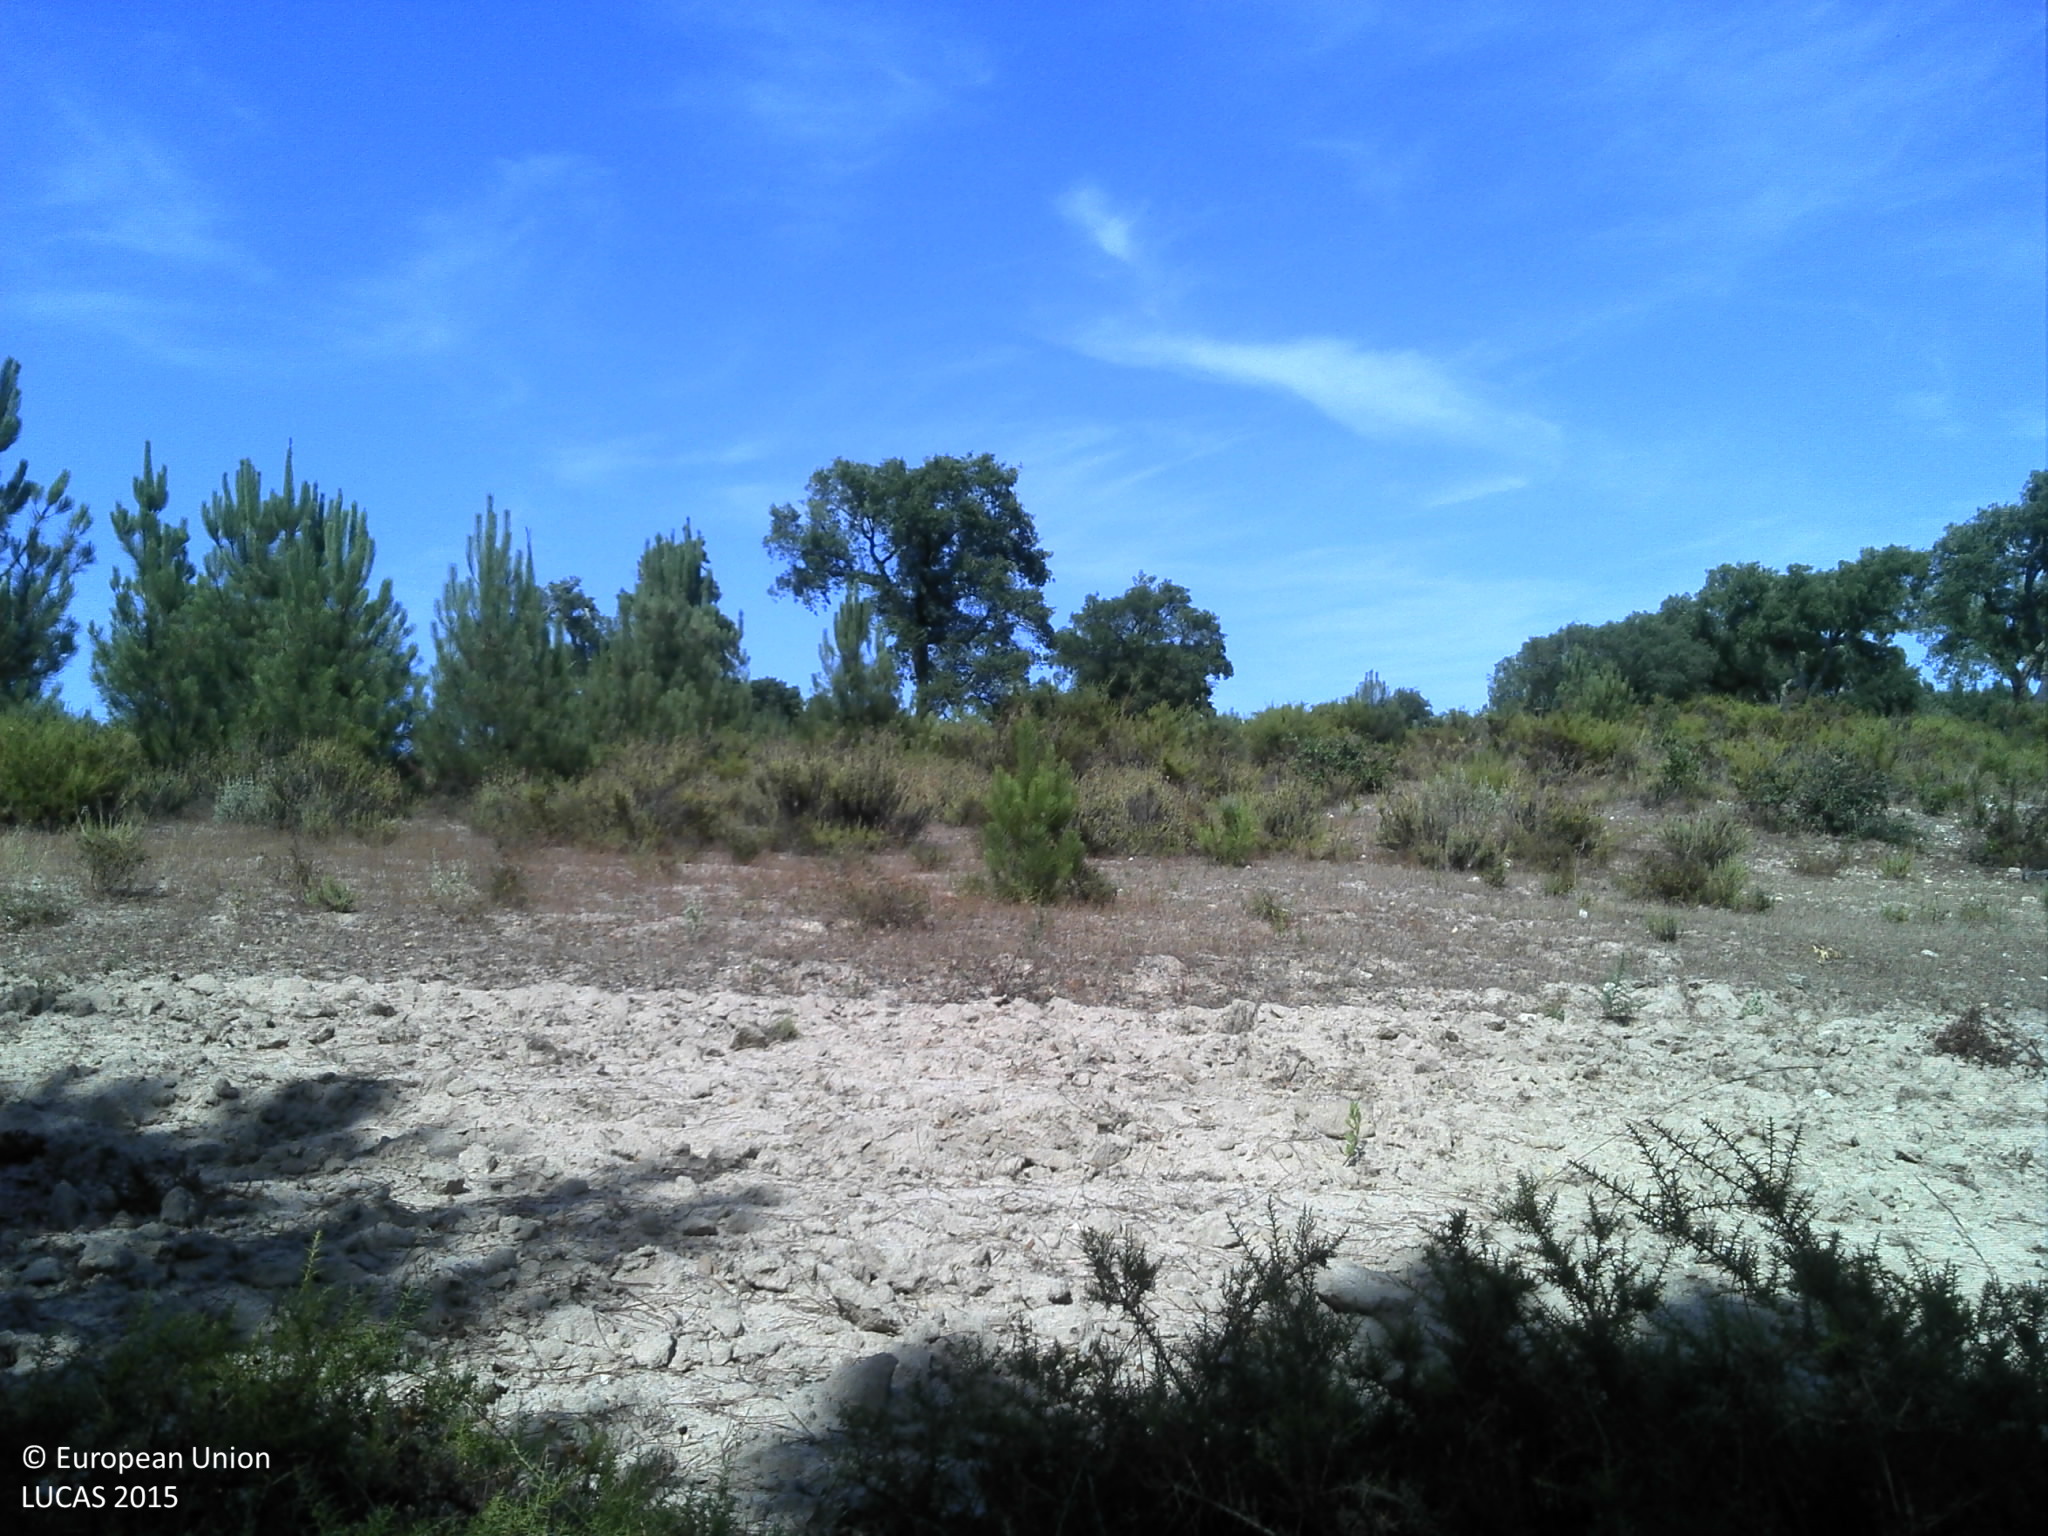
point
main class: Grassland
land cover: Grassland without tree/shrub cover
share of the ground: 50 - 75 %
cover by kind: herbaceous plants 90 %, unconsolidated bare surface 10 %
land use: Agriculture (excluding fallow land and kitchen gardens)
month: July
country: PT
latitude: 39.1871
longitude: -8.3428
